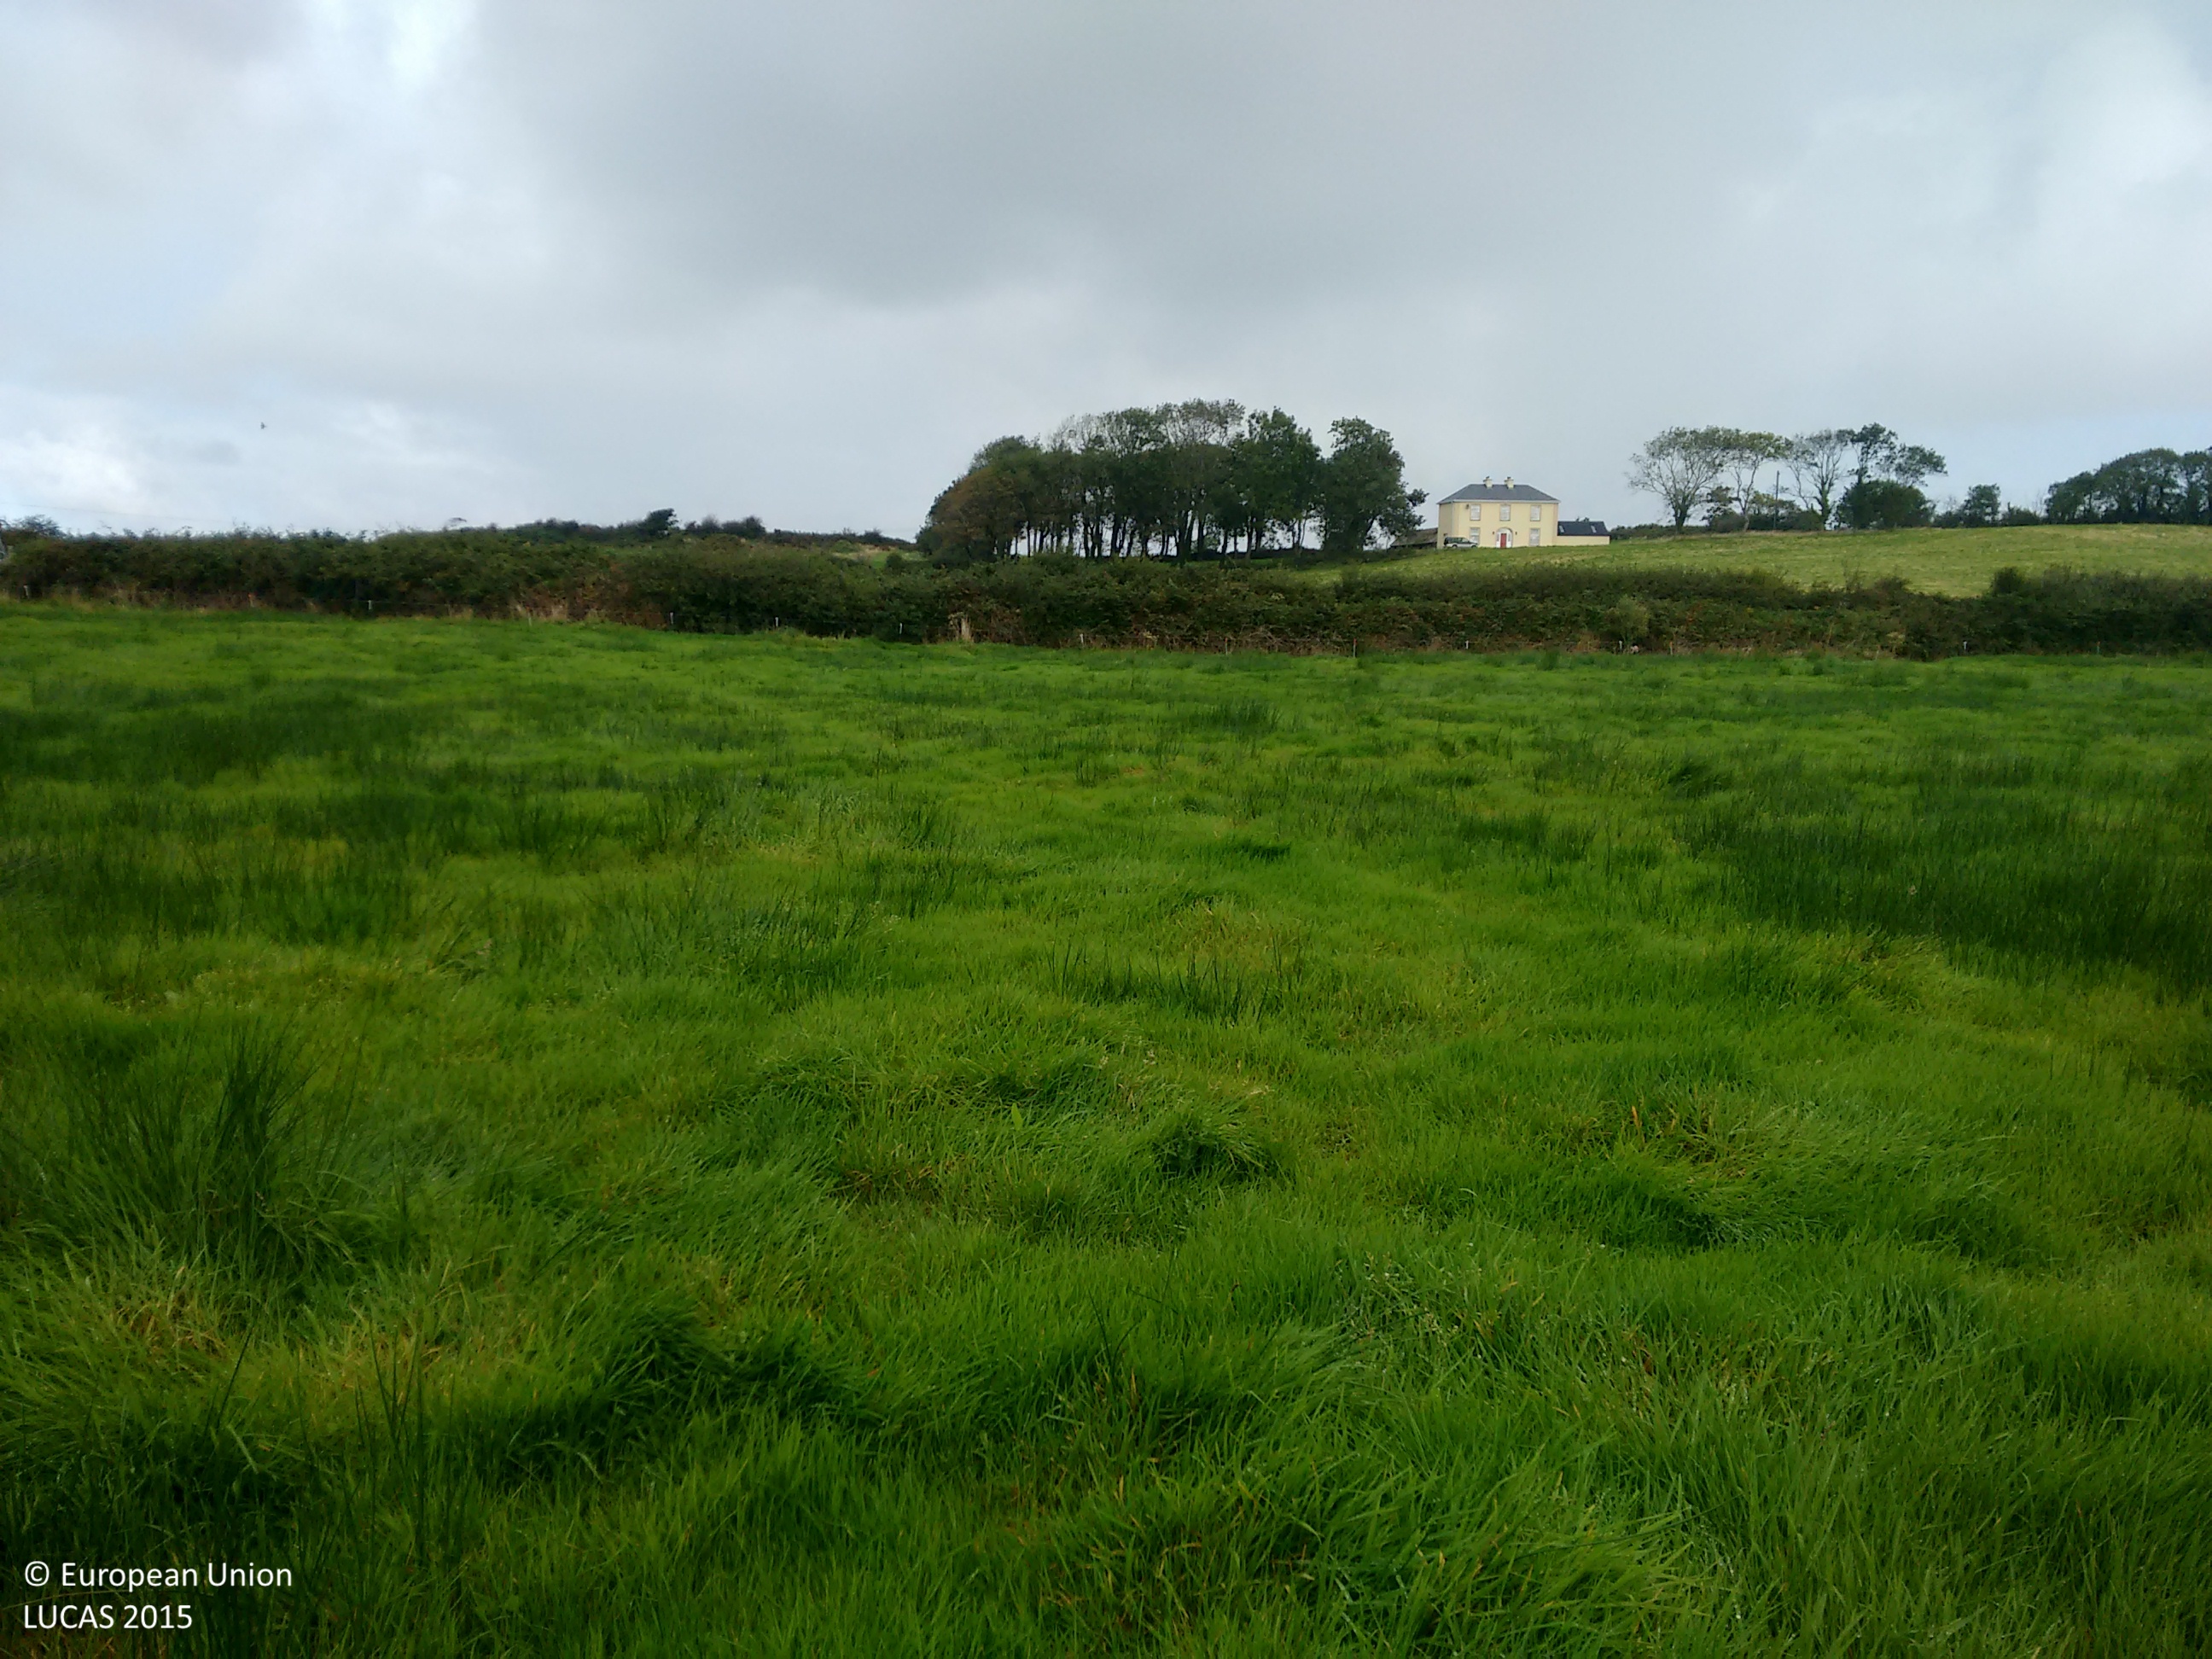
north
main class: Grassland
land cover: Grassland without tree/shrub cover
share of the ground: > 75 %
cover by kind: herbaceous plants 100 %
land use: Agriculture (excluding fallow land and kitchen gardens)
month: September
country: IE
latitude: 52.6362
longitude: -9.3323
